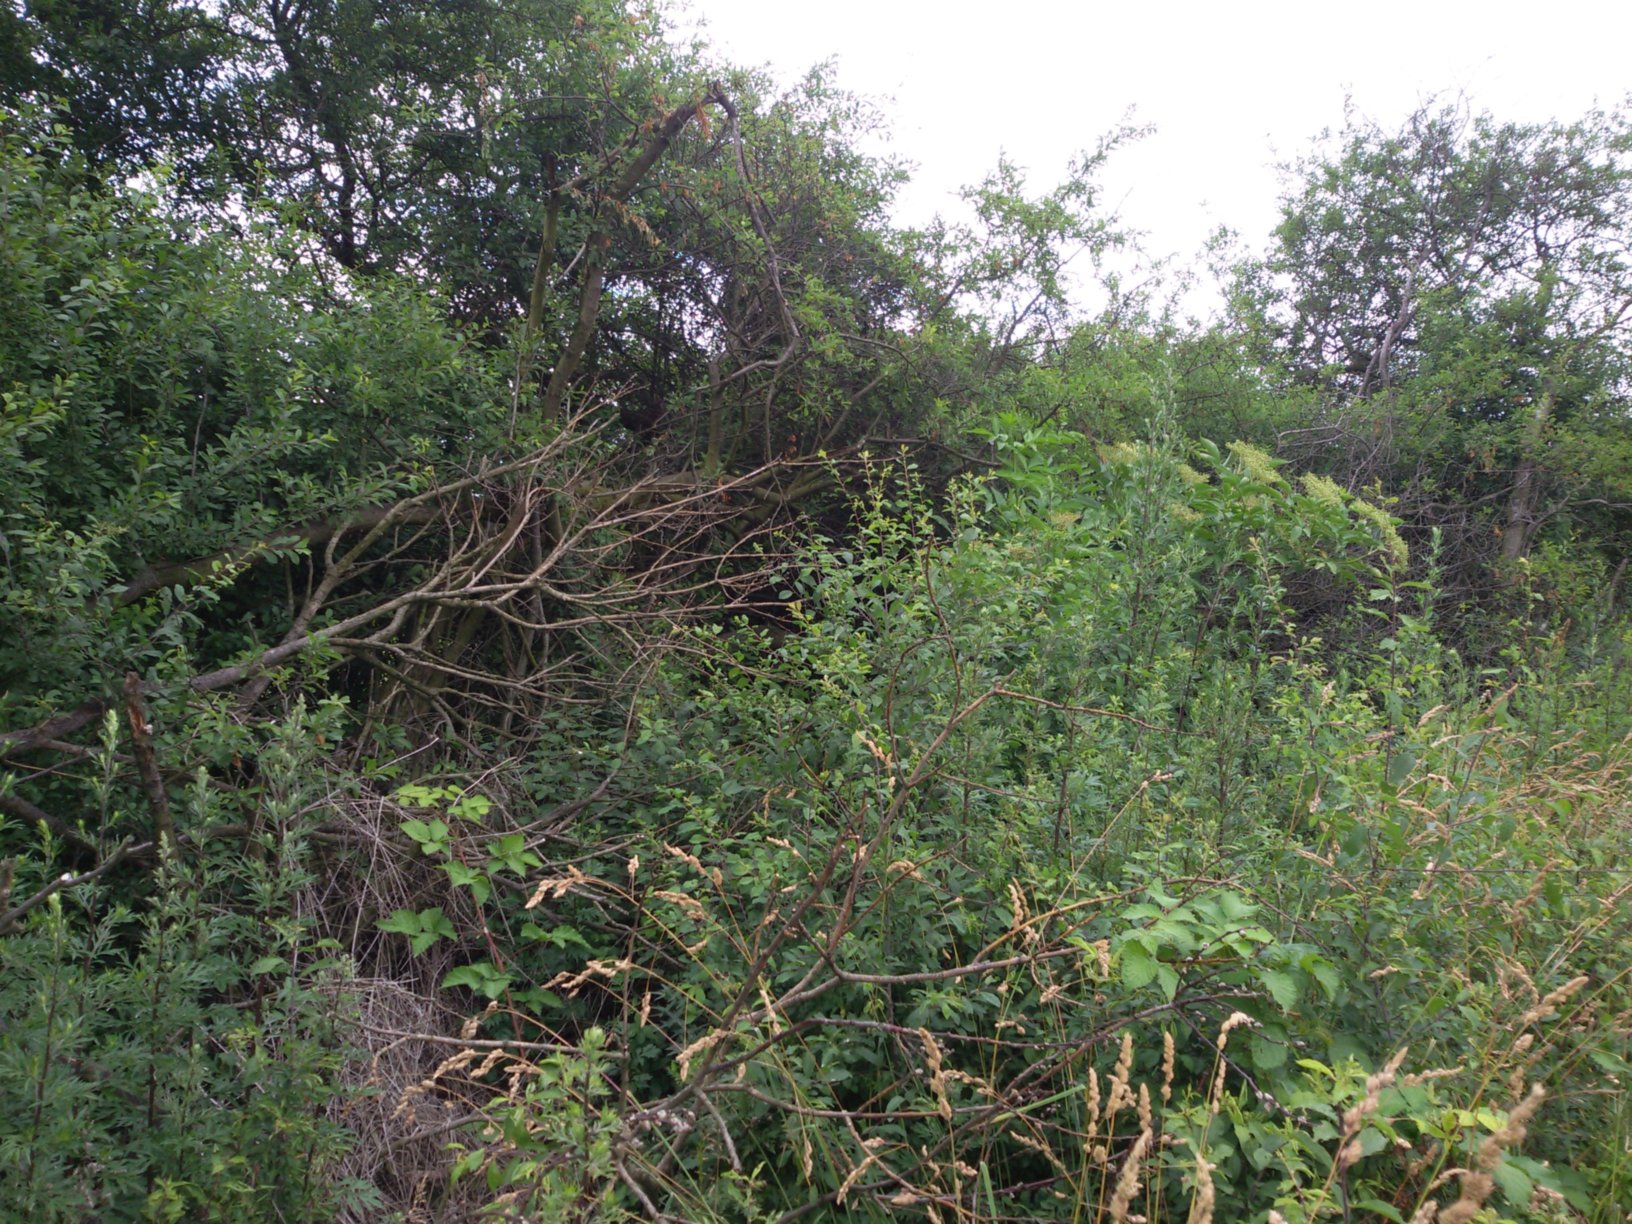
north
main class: Shrubland
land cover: Shrubland with sparse tree cover
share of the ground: > 75 %
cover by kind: shrubs 95 %, broadleaved forest trees 5 %
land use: Semi-natural and natural areas not in use
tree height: < 5 m
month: June
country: PL
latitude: 50.7314
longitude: 17.2226
